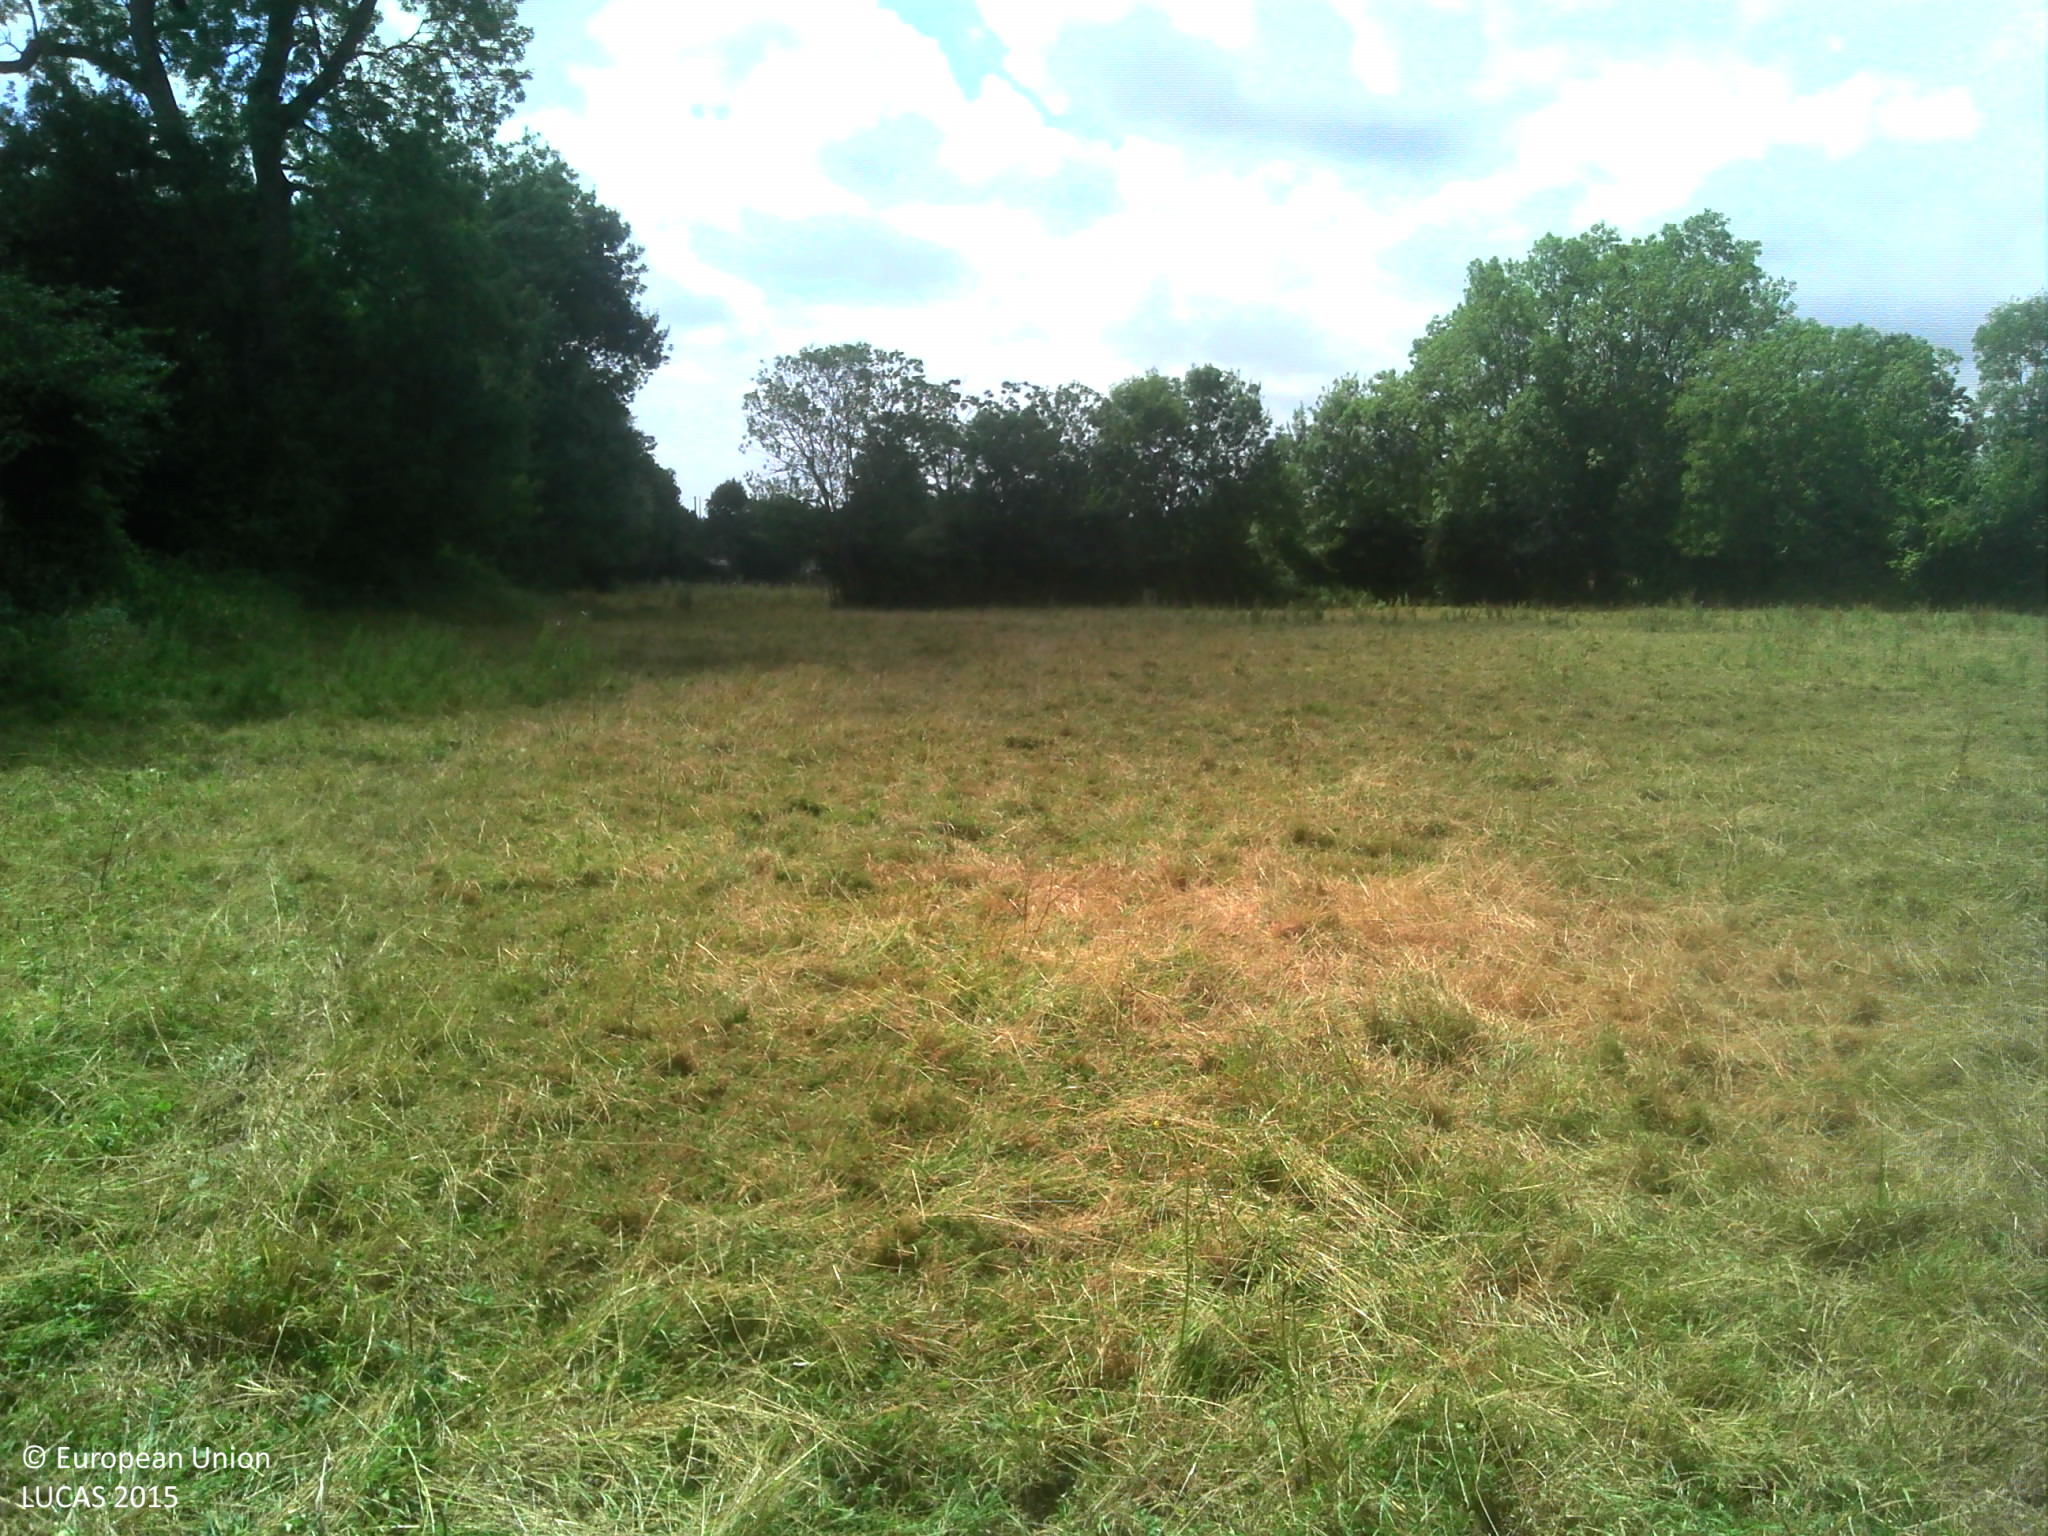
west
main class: Grassland
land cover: Grassland without tree/shrub cover
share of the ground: > 75 %
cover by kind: herbaceous plants 100 %
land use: Agriculture (excluding fallow land and kitchen gardens)
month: July
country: FR
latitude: 46.4923
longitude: -1.3313
